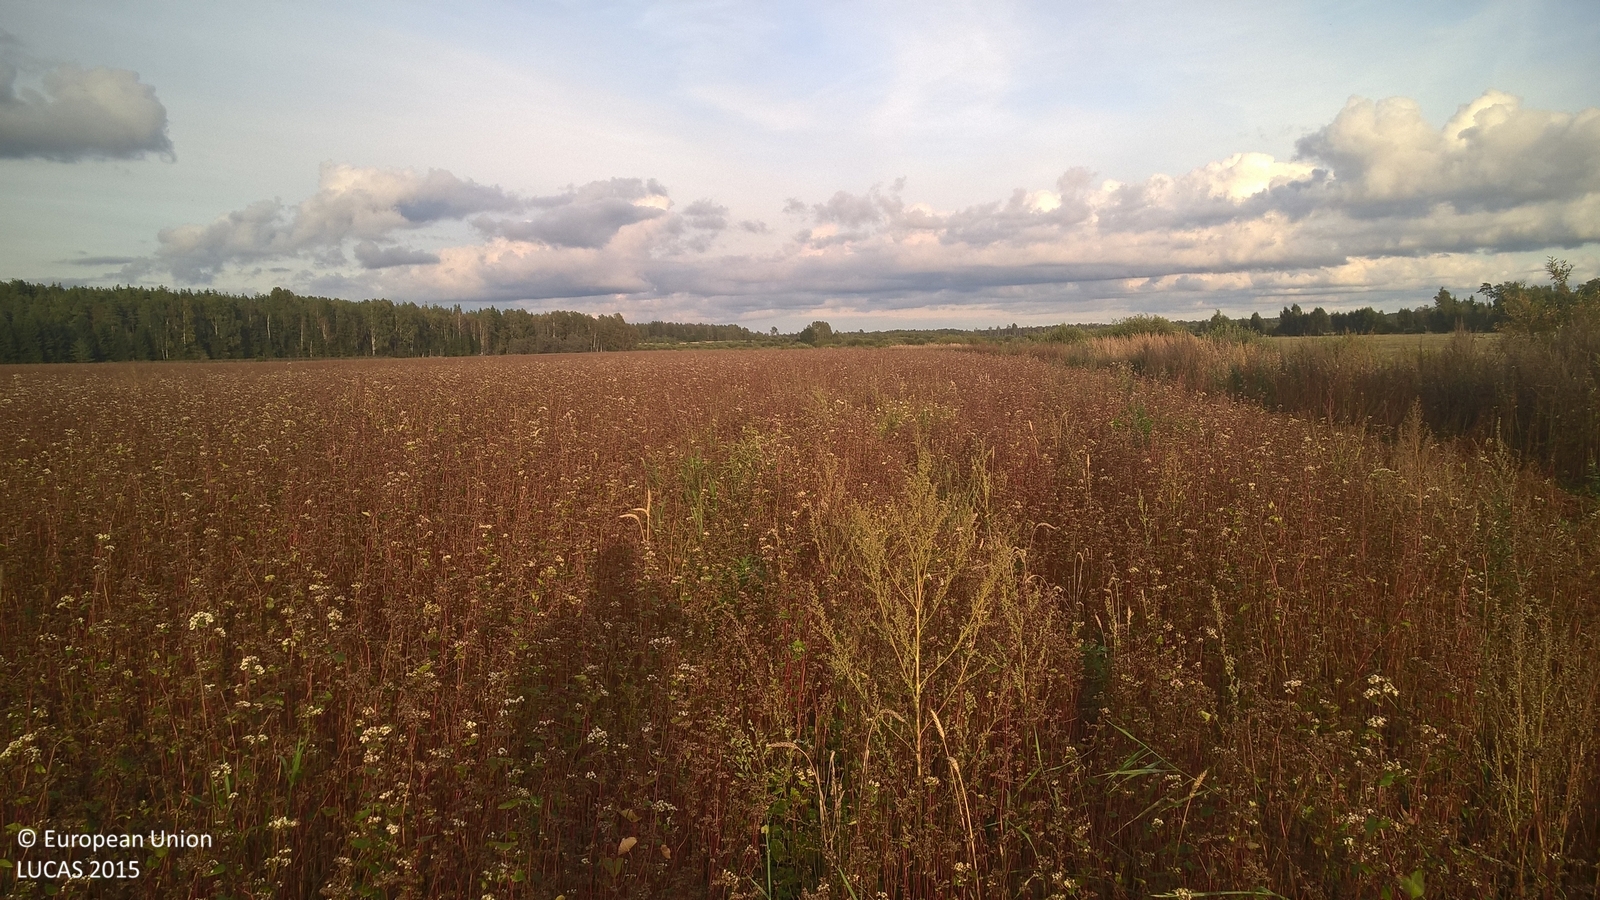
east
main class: Cropland
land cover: Other cereals
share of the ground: > 75 %
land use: Agriculture (excluding fallow land and kitchen gardens)
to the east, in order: Other cereals; Shruby margins; Ditches and canals; Abandoned hedges; Grassland without tree/shrub cover
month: September
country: LV
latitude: 57.8046
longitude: 25.6836
